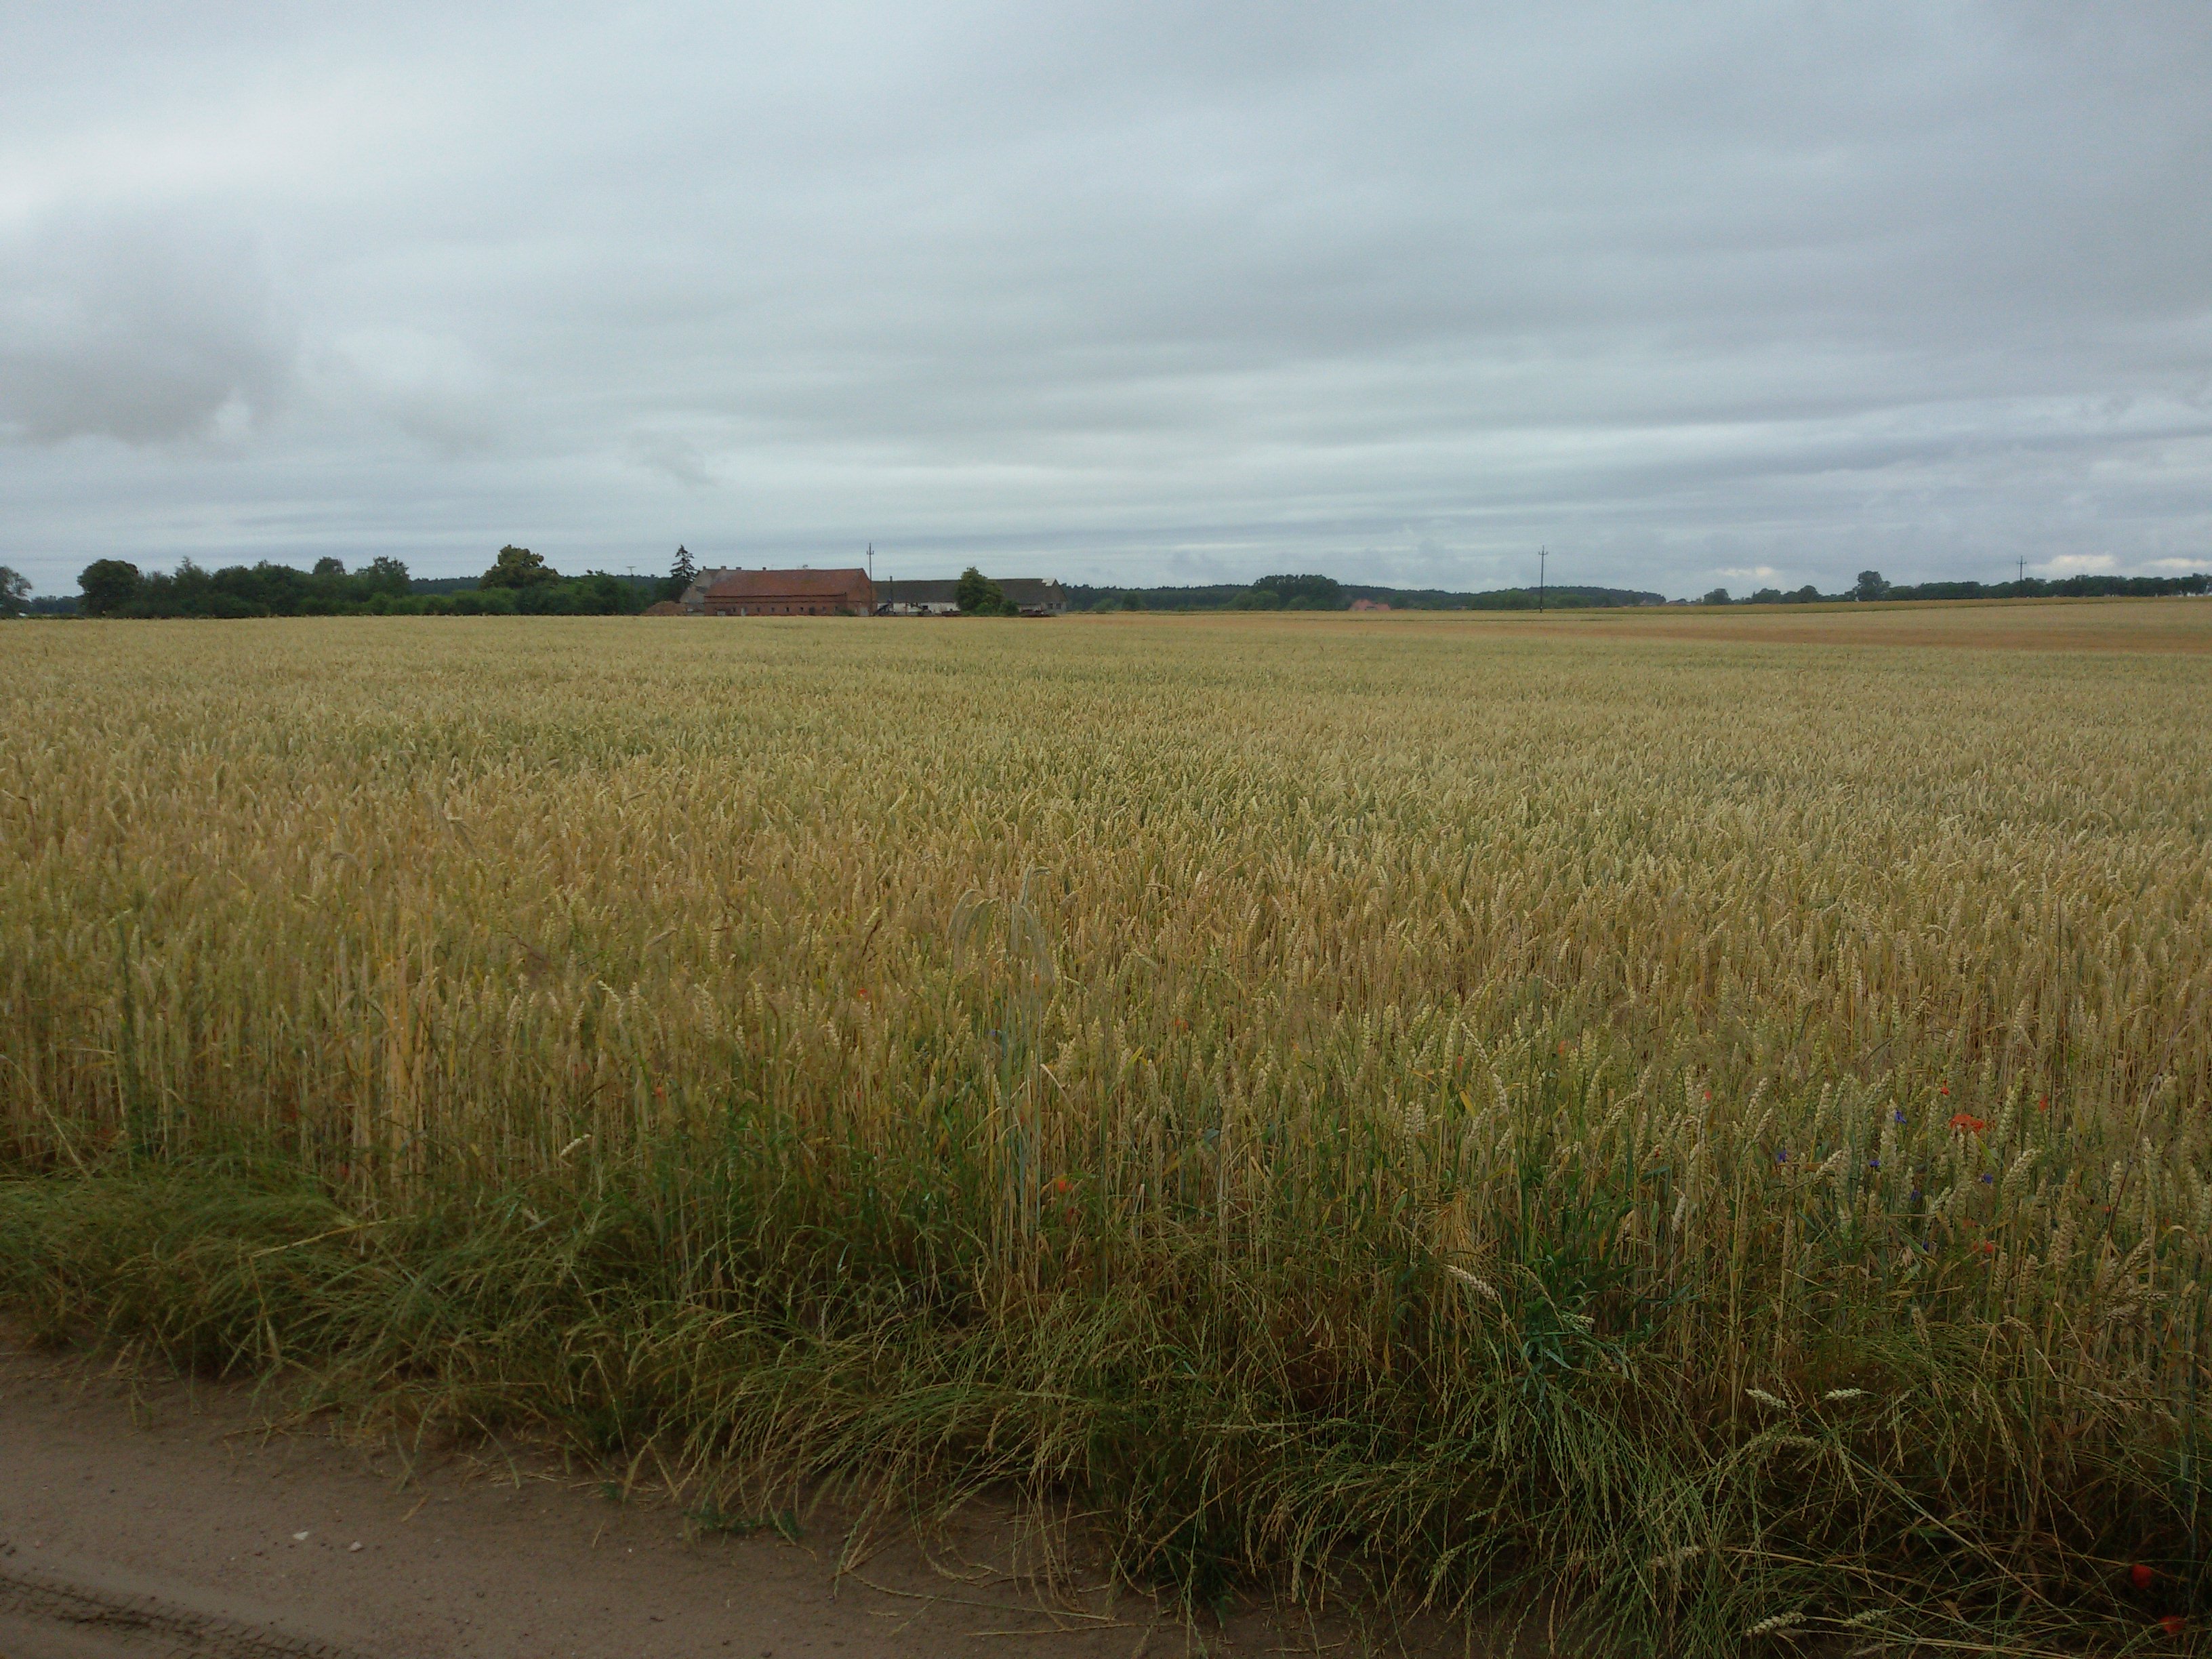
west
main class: Cropland
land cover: Barley
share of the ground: > 75 %
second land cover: Common wheat
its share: > 75 %
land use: Agriculture (excluding fallow land and kitchen gardens)
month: July
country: PL
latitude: 52.8897
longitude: 17.6376
